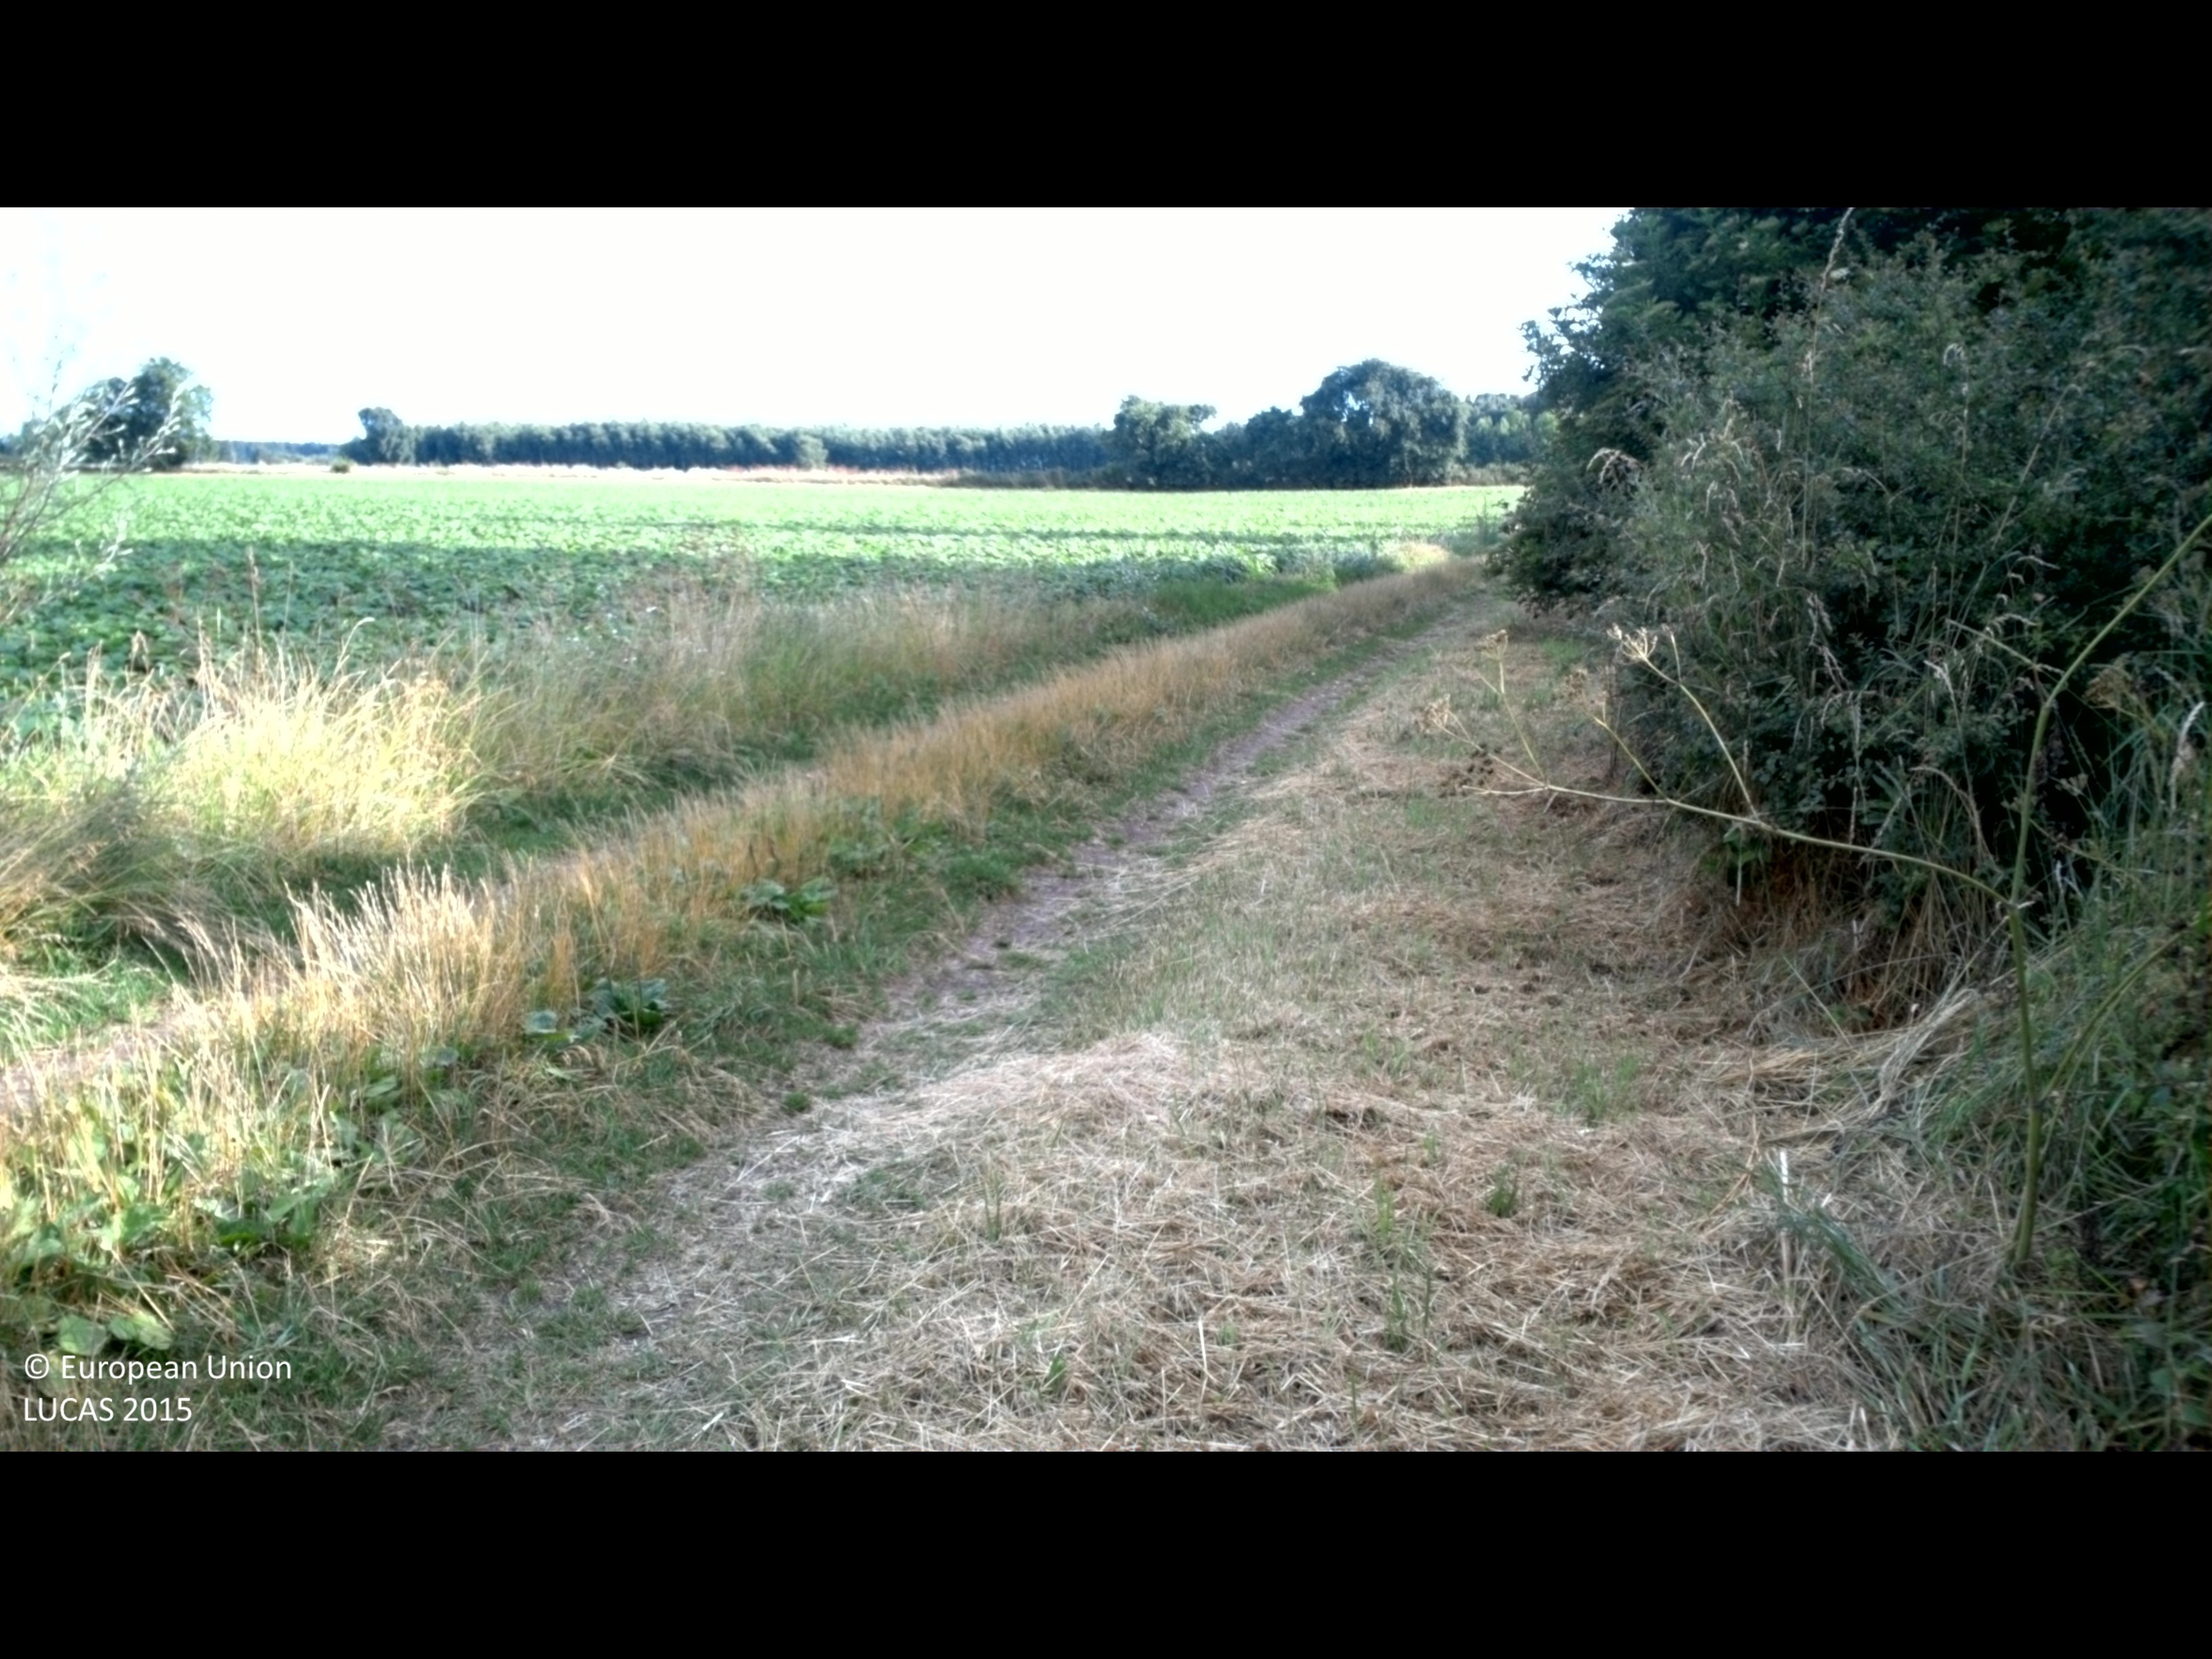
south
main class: Shrubland
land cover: Shrubland without tree cover
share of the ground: > 75 %
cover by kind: shrubs 80 %, herbaceous plants 20 %
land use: Semi-natural and natural areas not in use
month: July
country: SE
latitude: 56.5515
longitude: 16.3944
